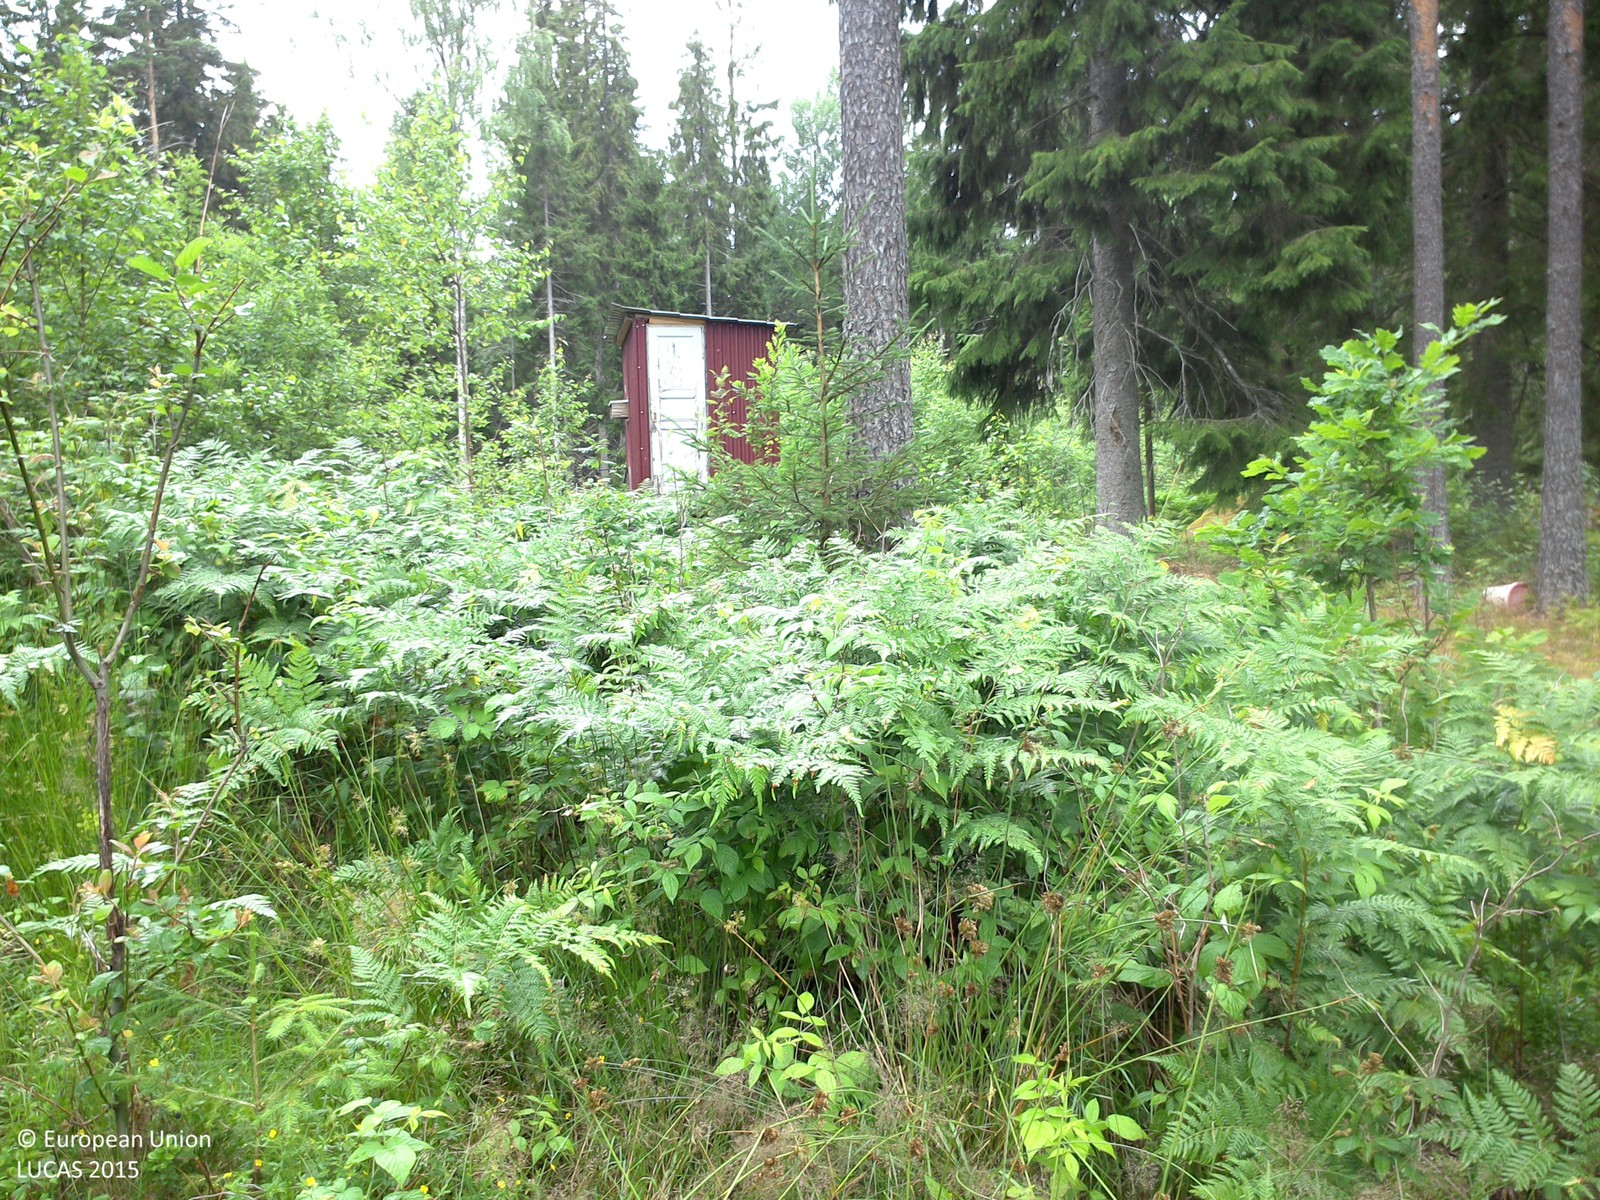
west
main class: Woodland
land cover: Pine dominated coniferous woodland
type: boreal forest
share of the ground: 50 - 75 %
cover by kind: coniferous forest trees 60 %, herbaceous plants 35 %, lichens and mosses 5 %
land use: Forestry
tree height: > 5 m
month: July
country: SE
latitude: 57.7804
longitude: 15.9668
